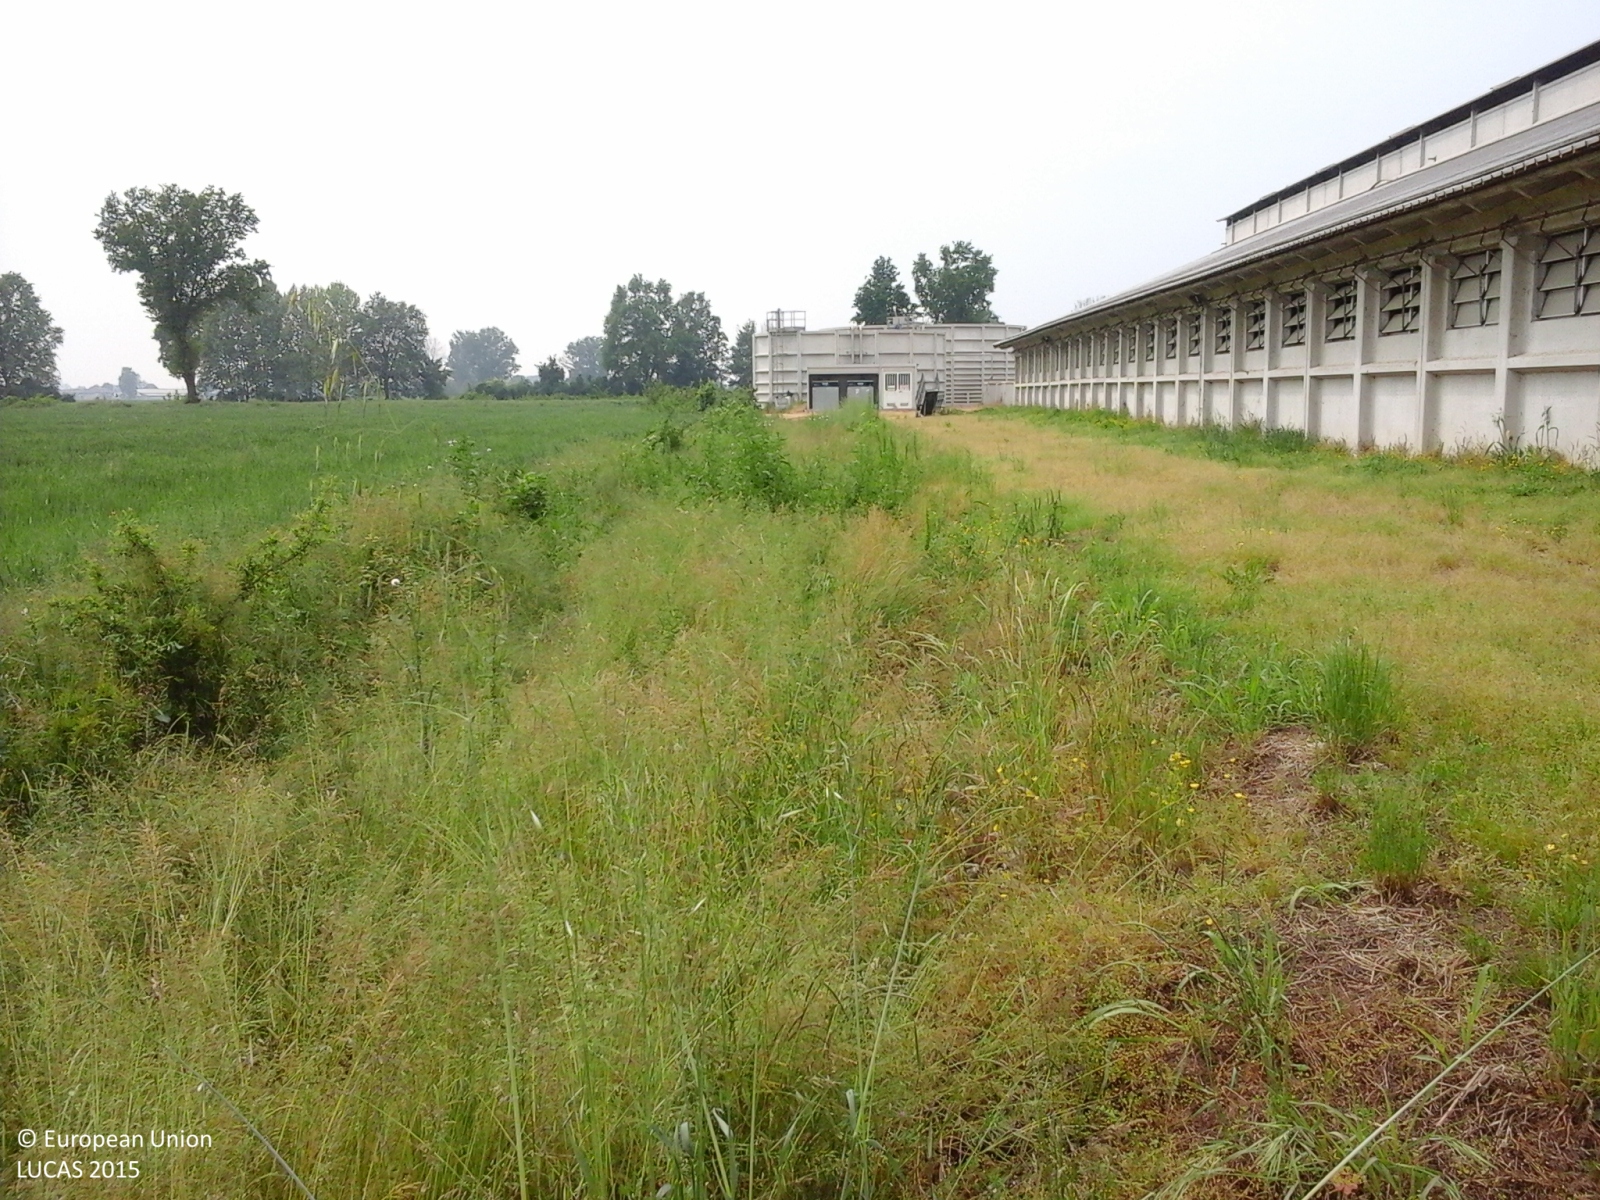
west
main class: Cropland
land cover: Common wheat
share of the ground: > 75 %
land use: Agriculture (excluding fallow land and kitchen gardens)
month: May
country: IT
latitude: 45.0716
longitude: 10.2155
